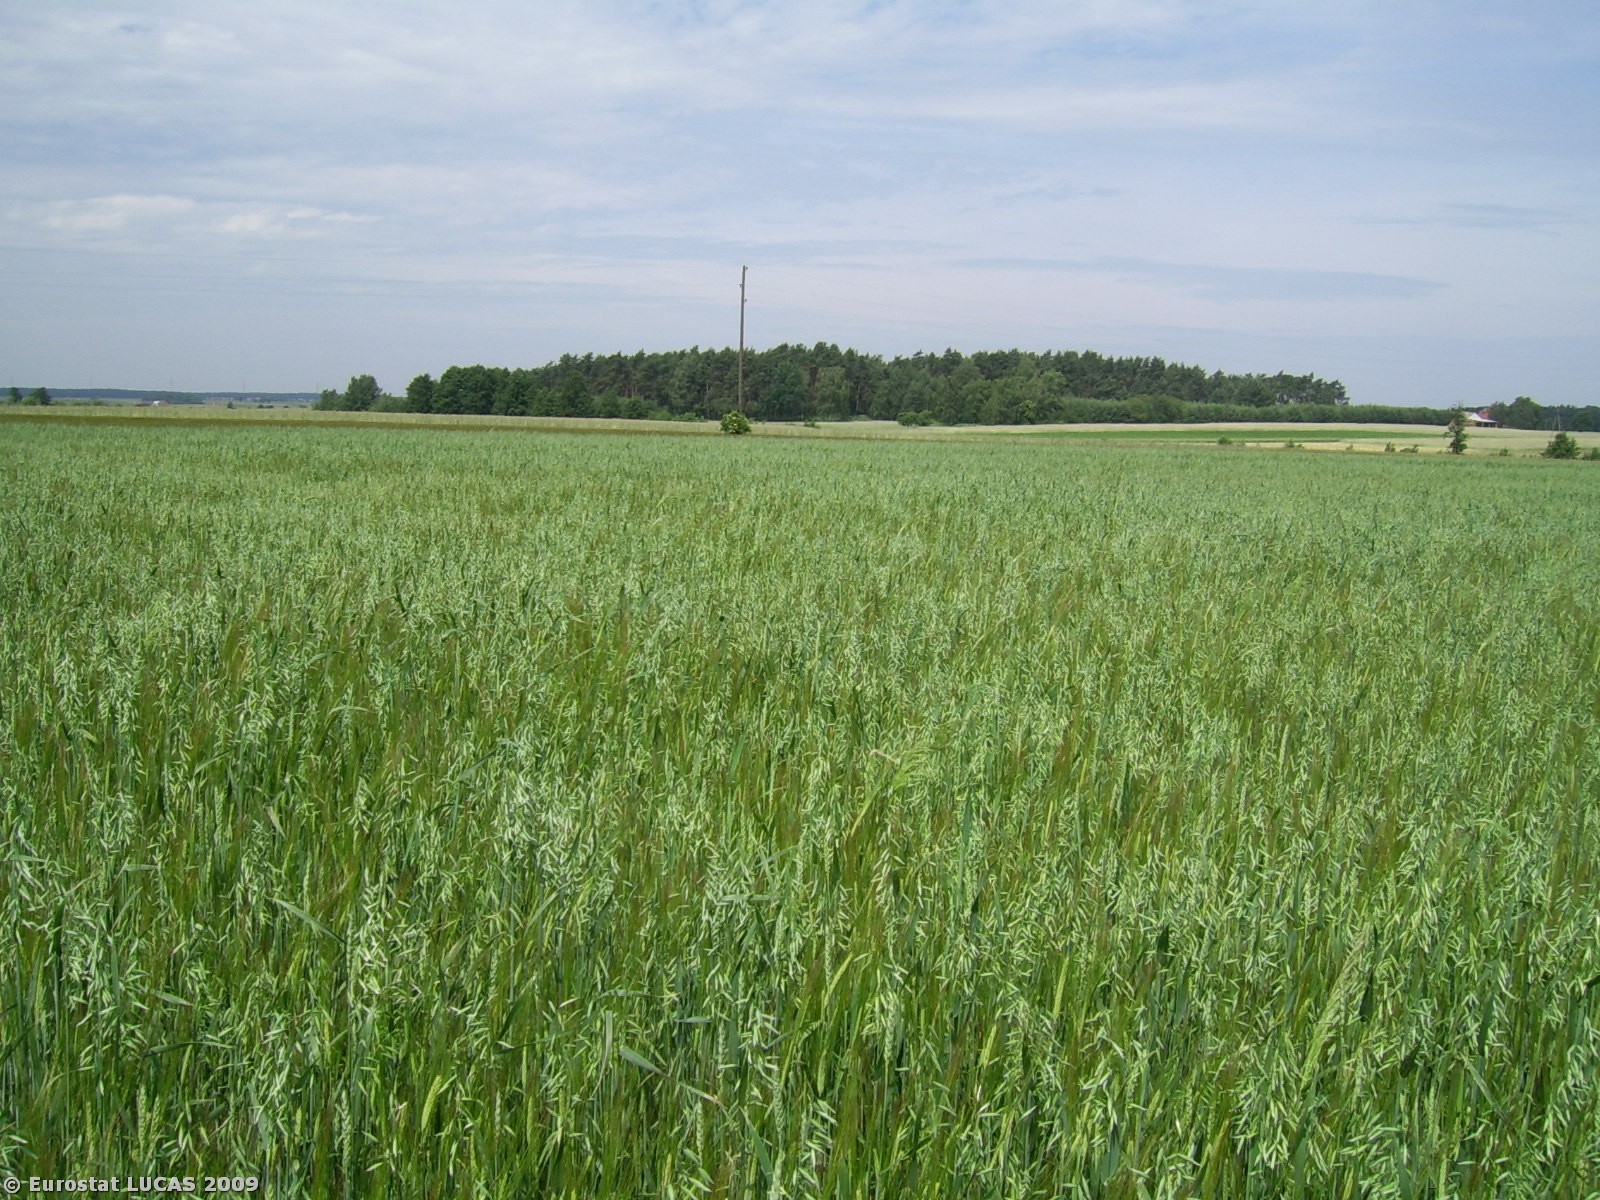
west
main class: Cropland
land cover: Mixed cereals for fodder
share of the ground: > 75 %
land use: Agriculture (excluding fallow land and kitchen gardens)
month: June
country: PL
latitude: 51.7814
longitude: 17.7401
